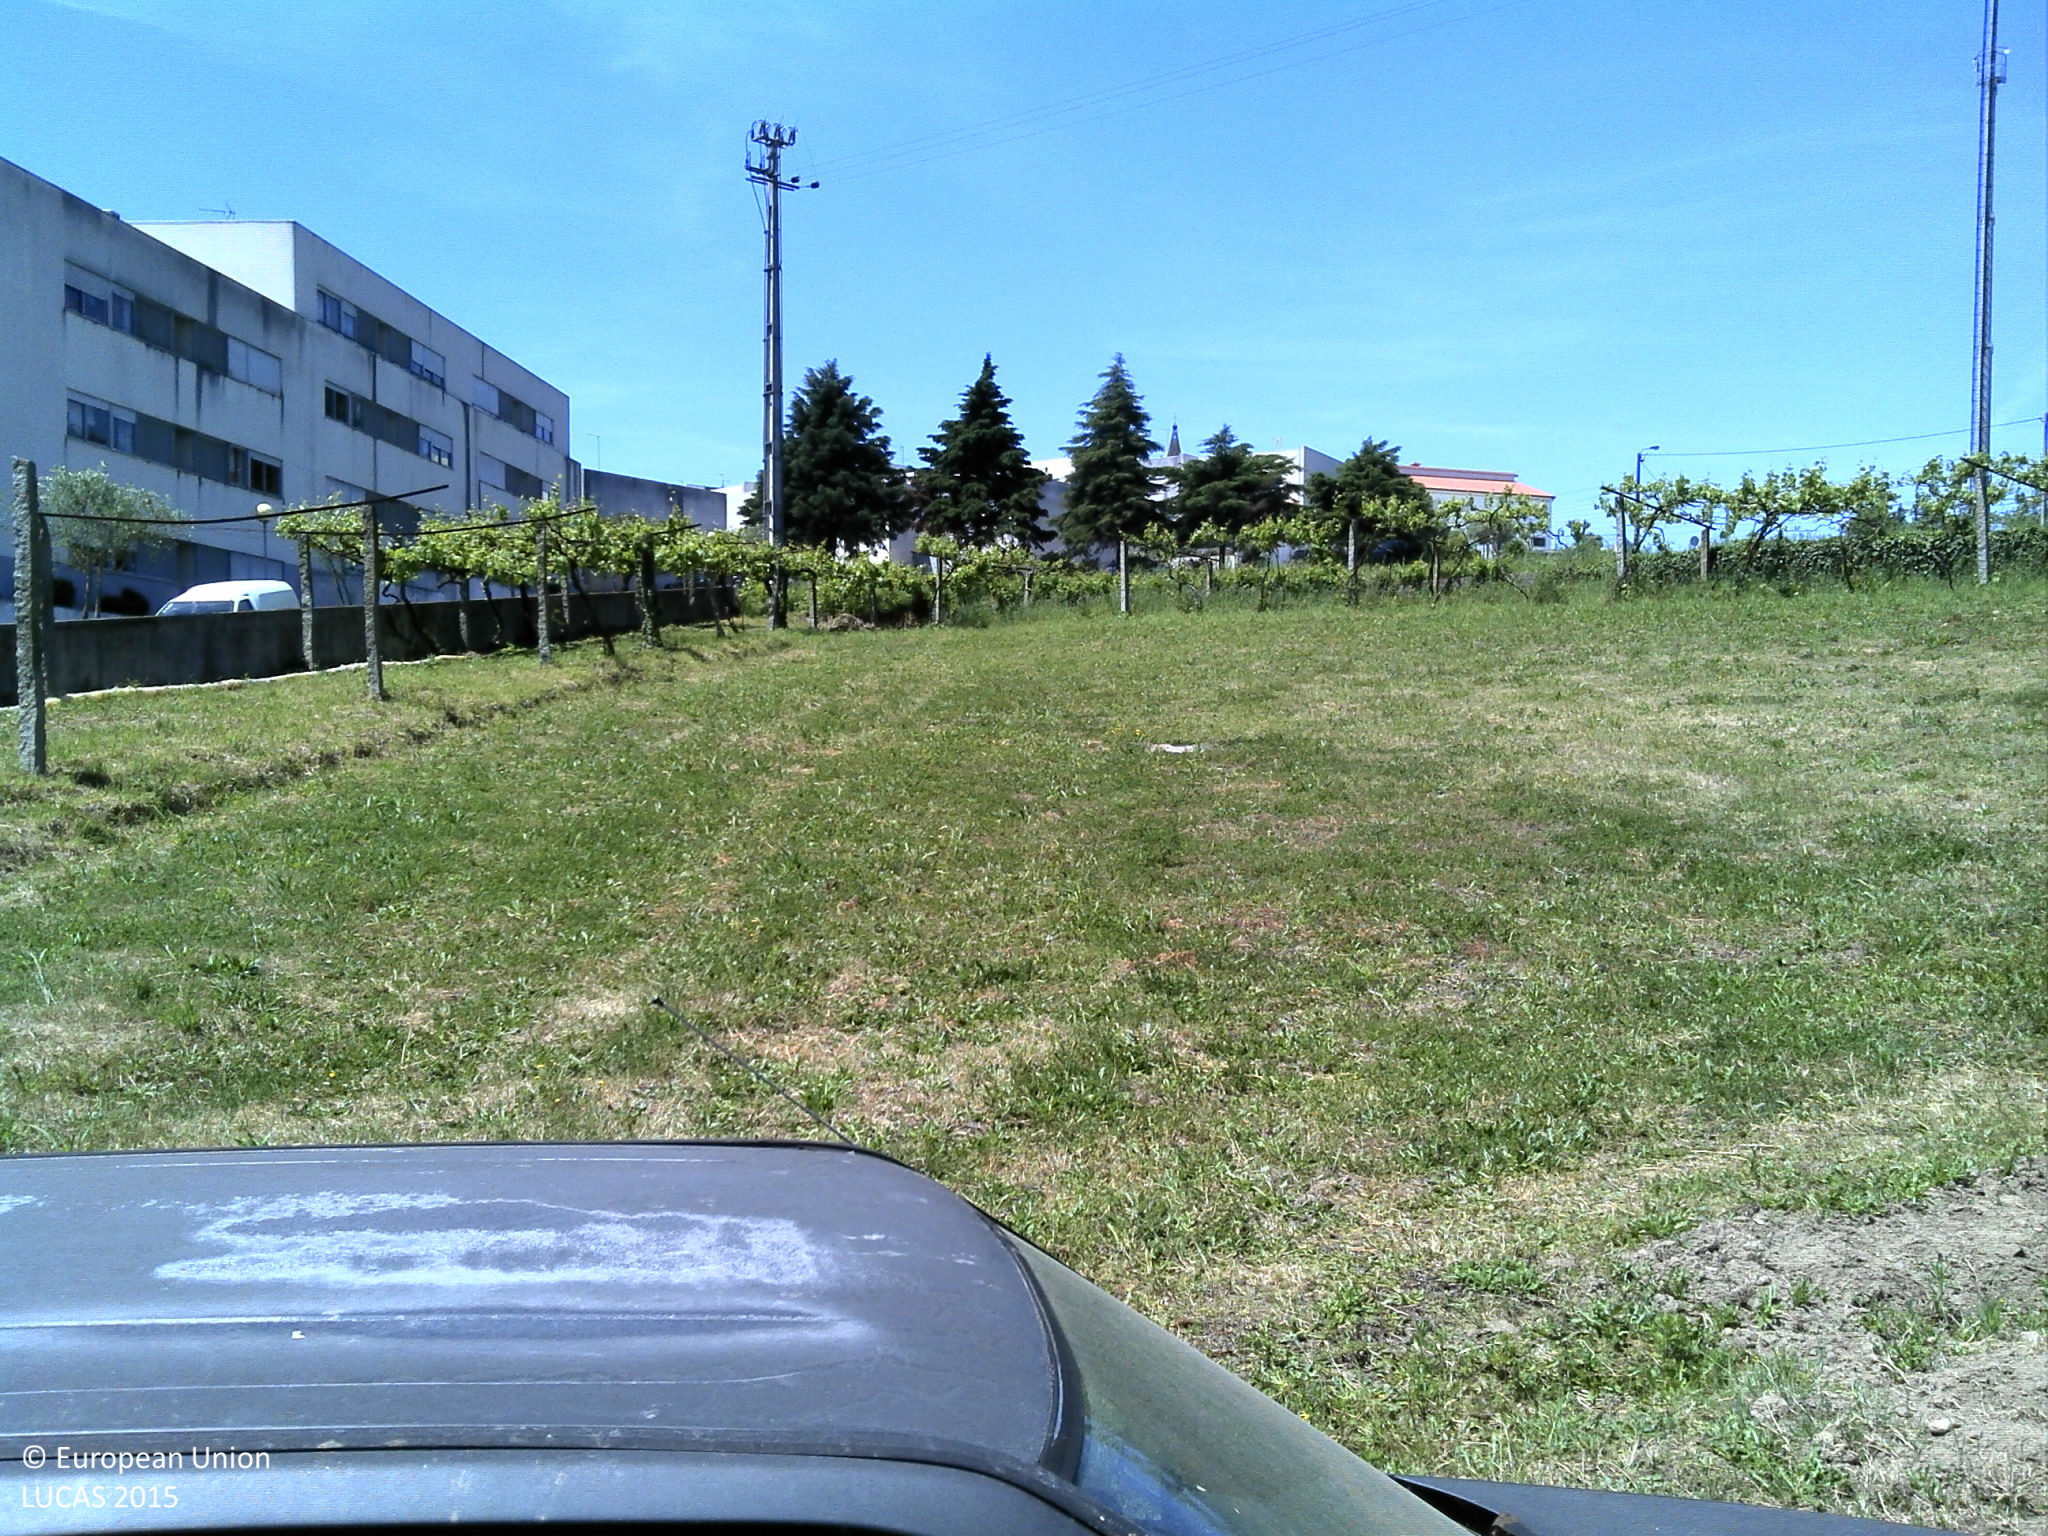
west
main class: Grassland
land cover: Grassland without tree/shrub cover
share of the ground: 50 - 75 %
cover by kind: herbaceous plants 75 %, consolidated bare surface 25 %
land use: Agriculture (excluding fallow land and kitchen gardens)
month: May
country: PT
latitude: 41.3788
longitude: -8.4831
